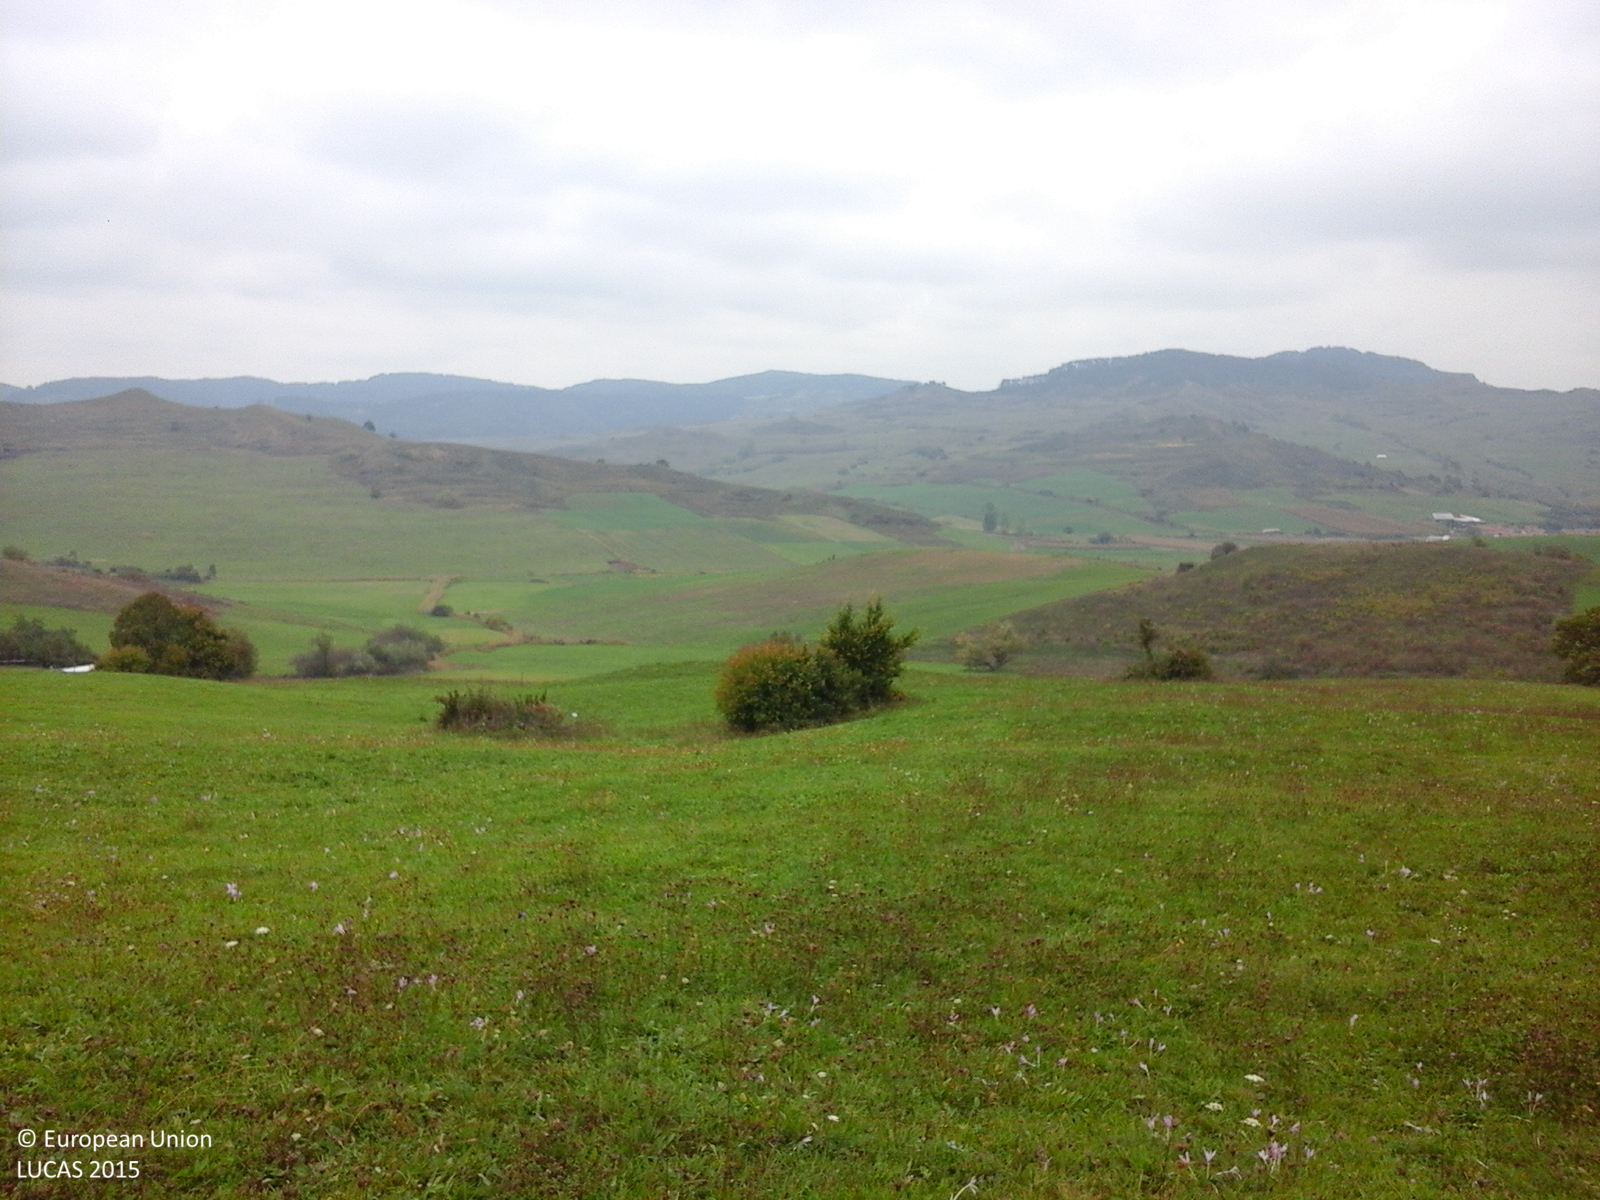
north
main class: Grassland
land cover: Grassland without tree/shrub cover
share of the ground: > 75 %
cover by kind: herbaceous plants 100 %
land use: Agriculture (excluding fallow land and kitchen gardens)
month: October
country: RO
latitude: 46.2601
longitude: 24.8429
